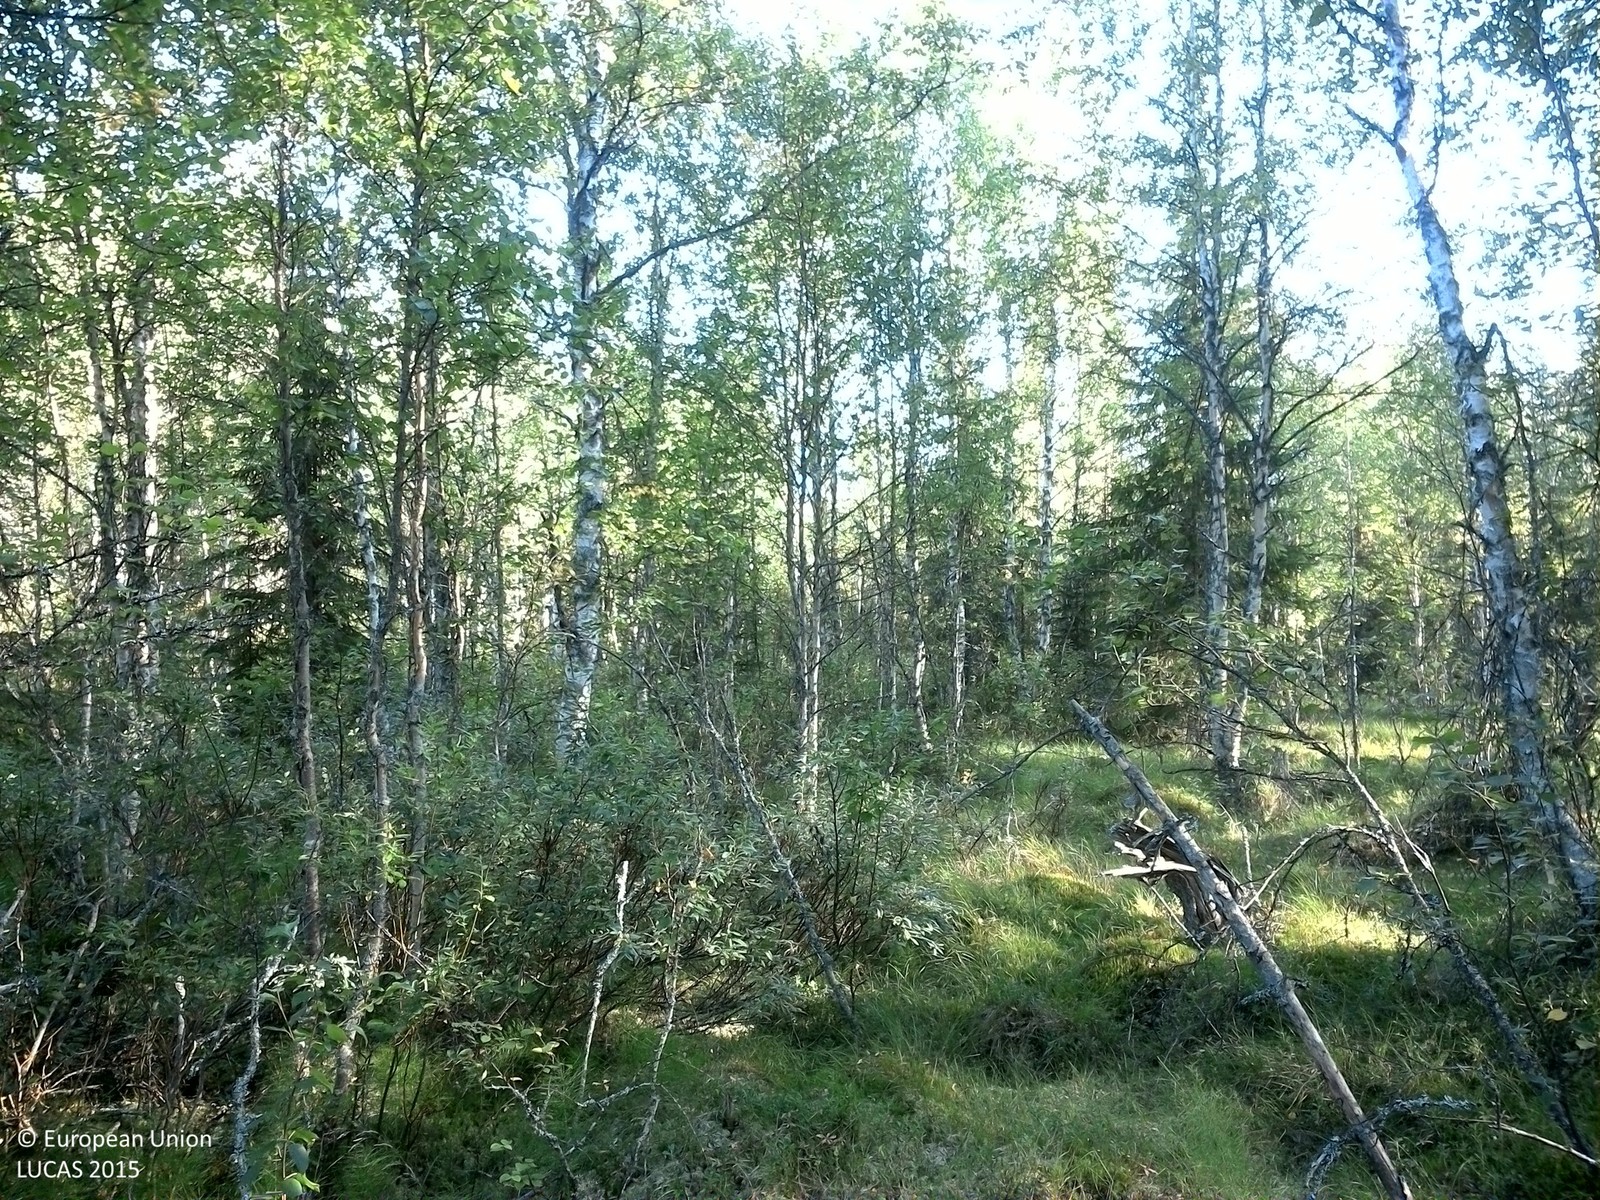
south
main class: Woodland
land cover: Pine dominated mixed woodland
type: boreal forest
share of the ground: > 75 %
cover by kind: coniferous forest trees 50 %, broadleaved forest trees 25 %, shrubs 20 %, herbaceous plants 5 %
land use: Forestry
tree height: > 5 m
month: August
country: SE
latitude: 63.9203
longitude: 17.3311
